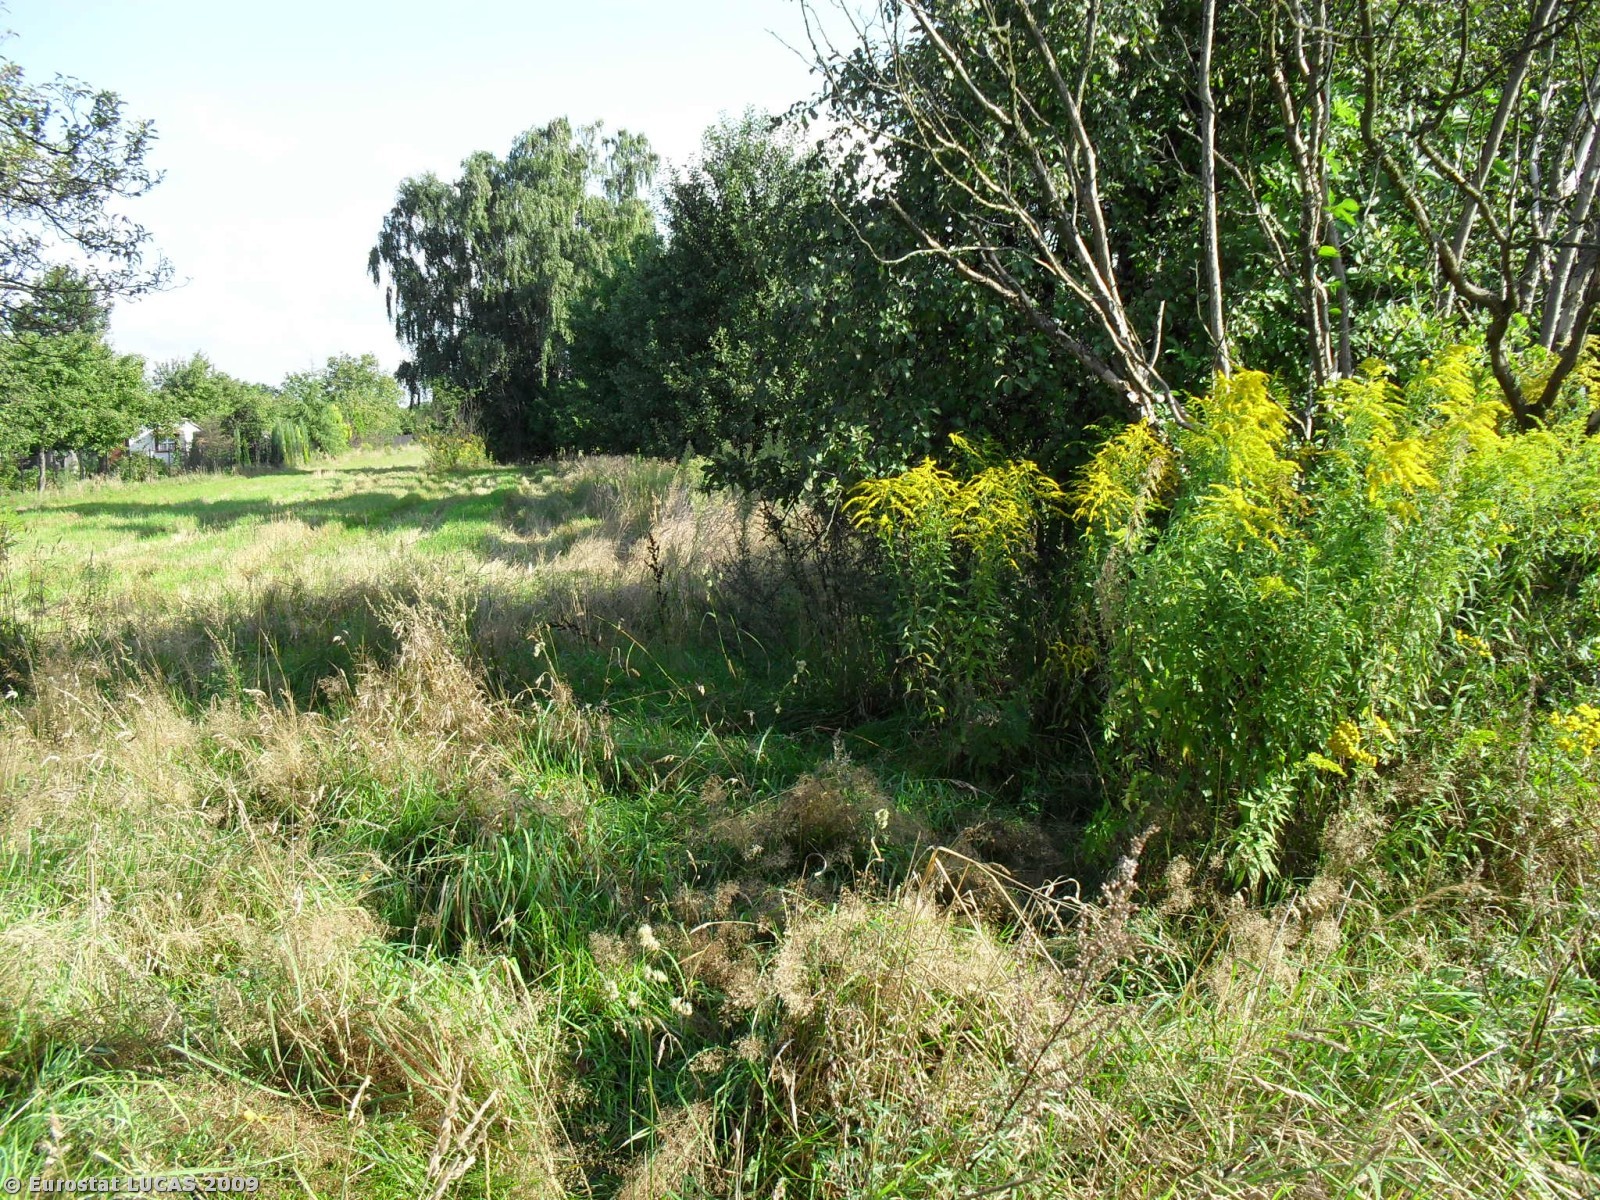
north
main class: Grassland
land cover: Grassland with sparse tree/shrub cover
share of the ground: > 75 %
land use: Agriculture (excluding fallow land and kitchen gardens)
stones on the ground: < 10 %
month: August
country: PL
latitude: 51.8123
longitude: 19.5289
